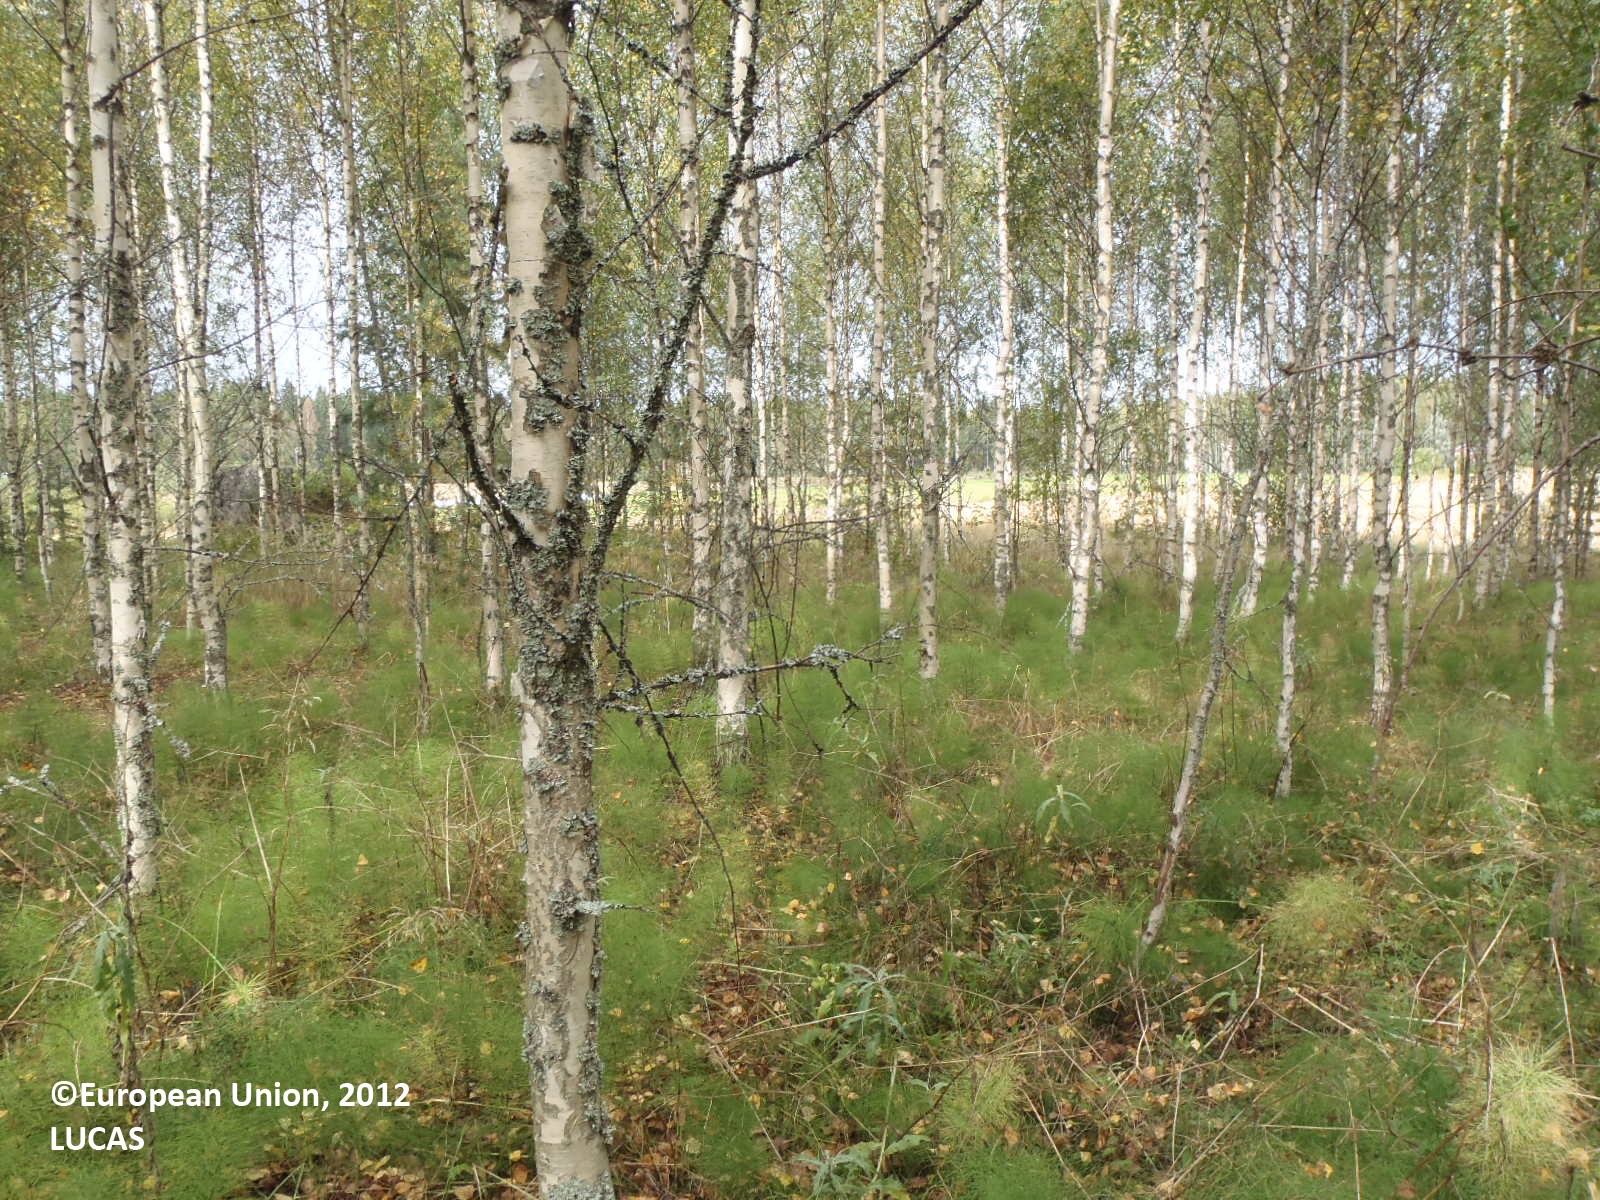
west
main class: Woodland
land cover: Broadleaved woodland
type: boreal forest
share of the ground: > 75 %
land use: Forestry
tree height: > 5 m
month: September
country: FI
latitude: 61.3206
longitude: 22.7138
